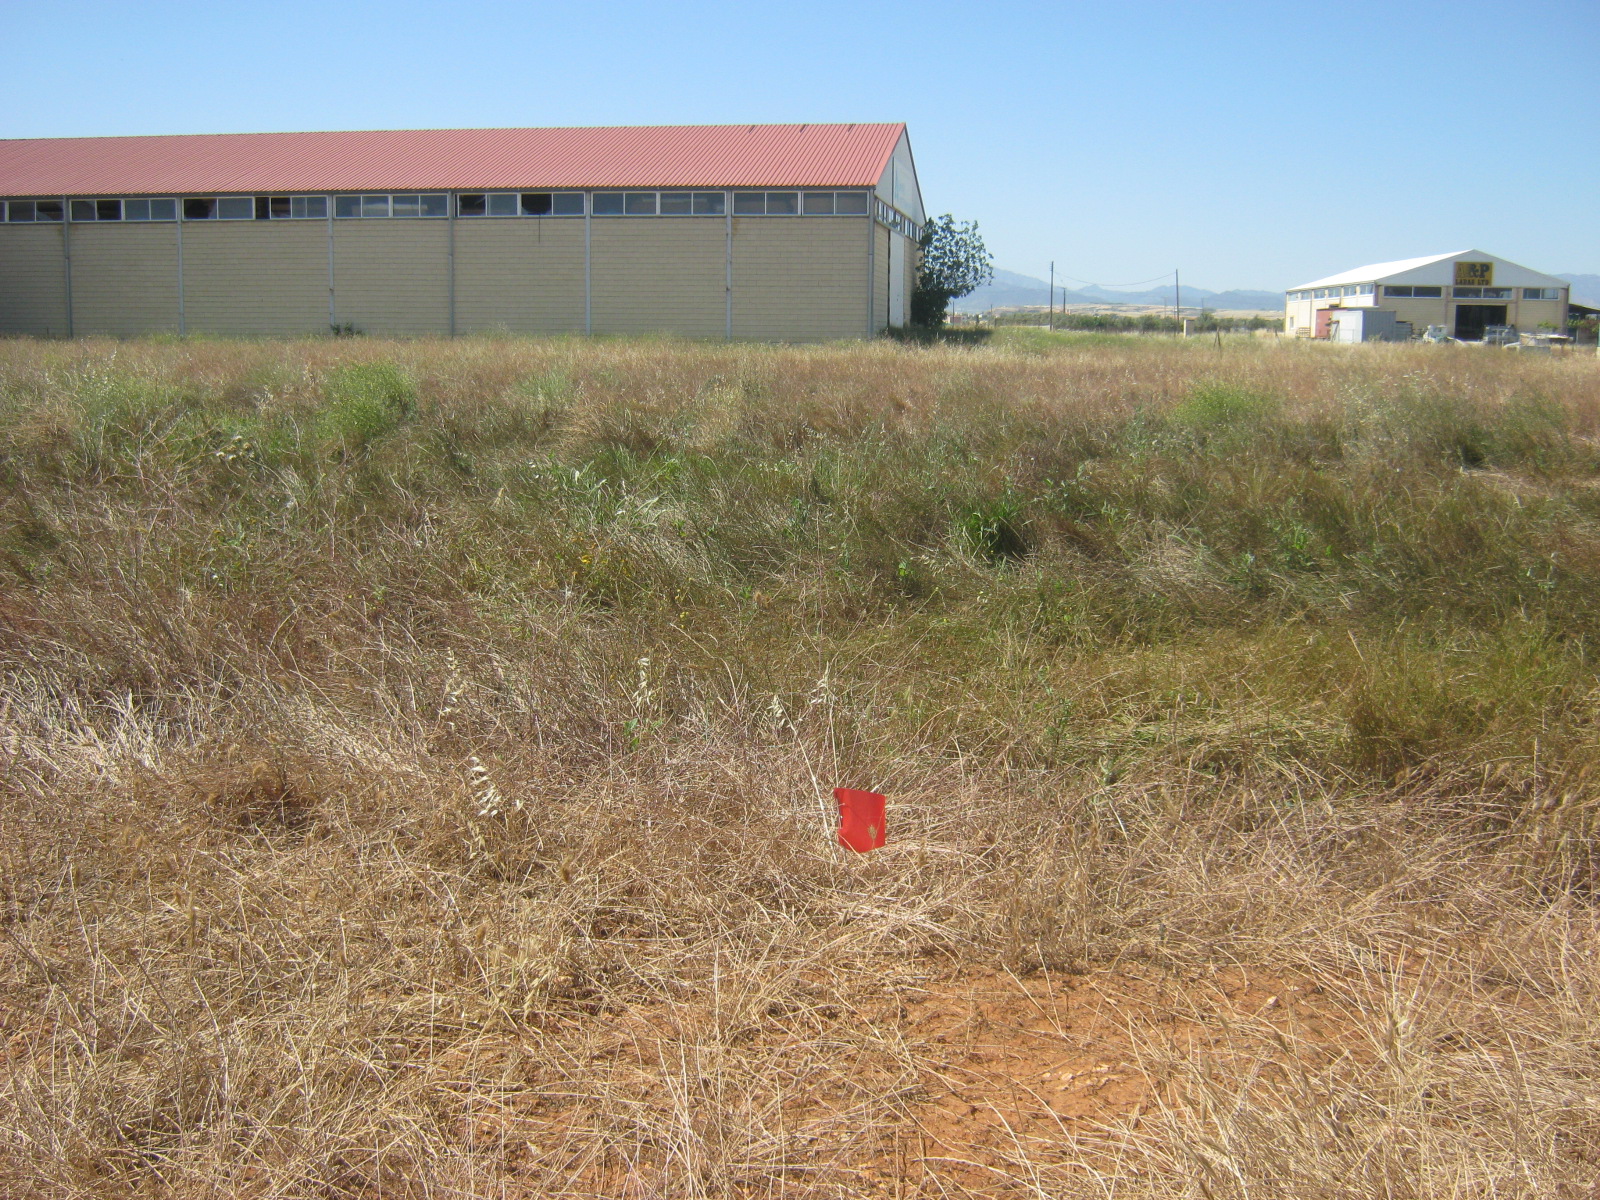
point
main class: Grassland
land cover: Grassland without tree/shrub cover
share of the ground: 50 - 75 %
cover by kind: herbaceous plants 65 %, unconsolidated bare surface 30 %, shrubs 5 %
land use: Semi-natural and natural areas not in use
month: May
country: CY
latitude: 35.1482
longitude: 33.2277
